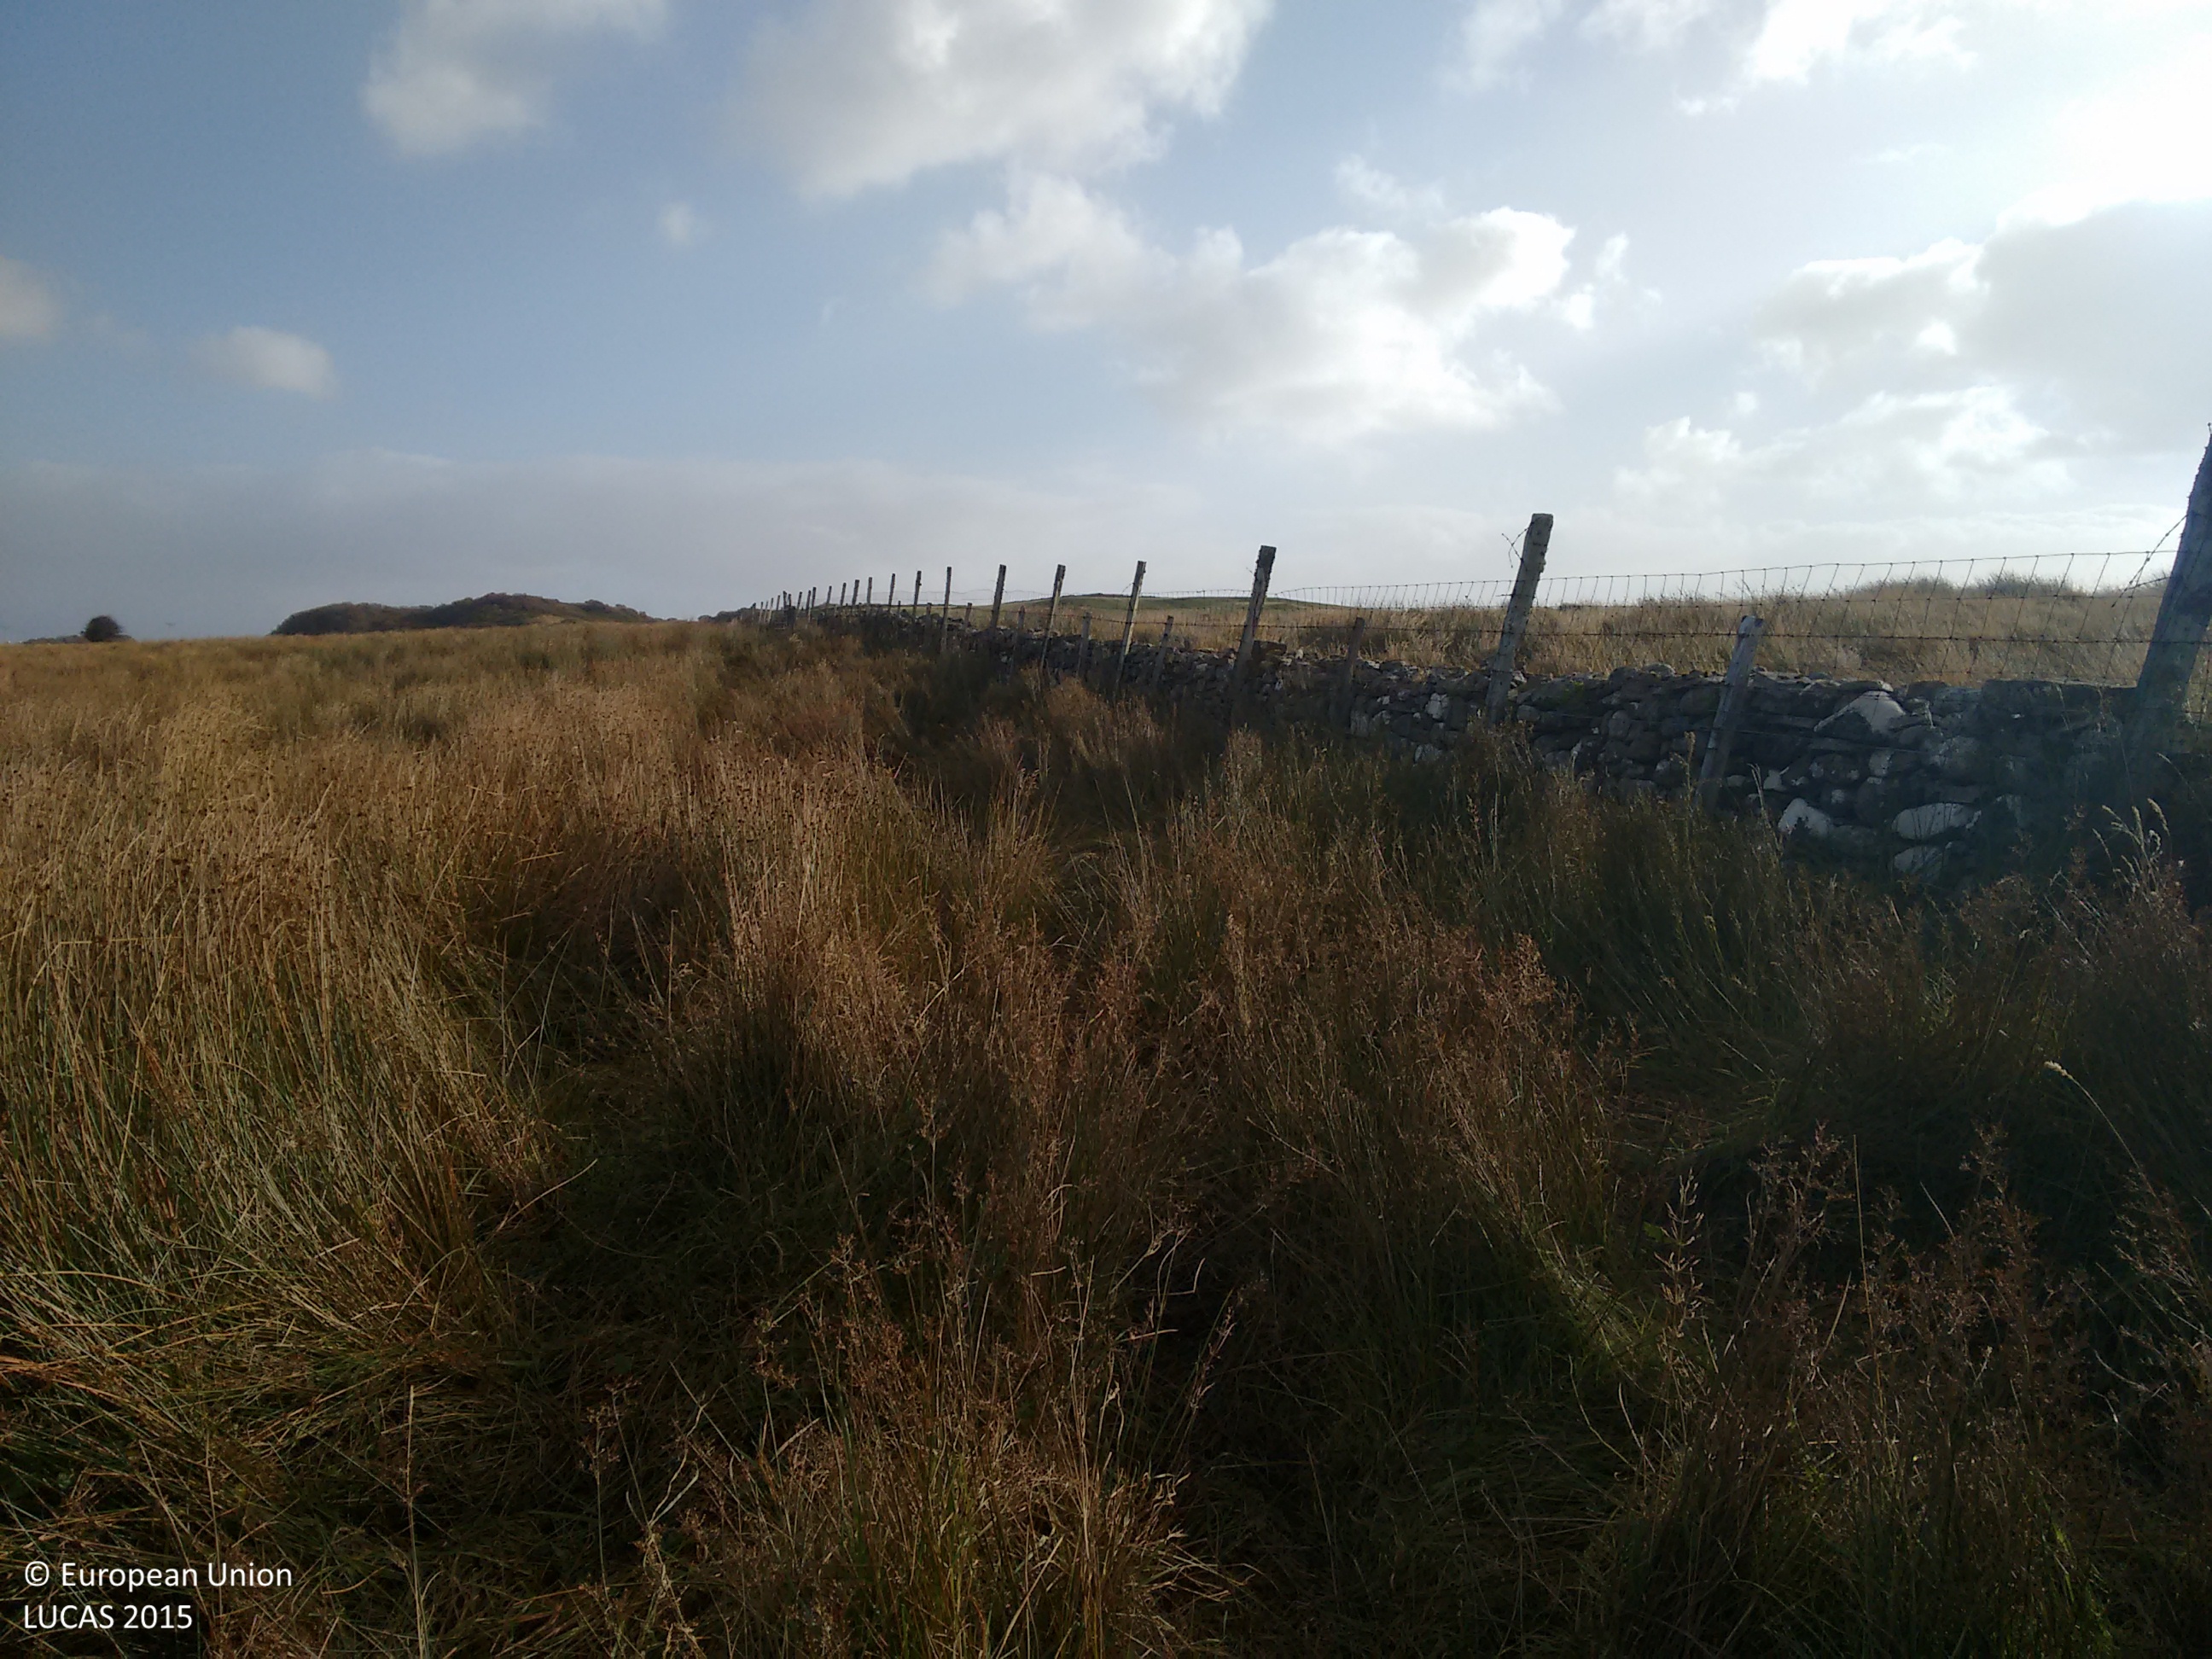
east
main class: Grassland
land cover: Grassland without tree/shrub cover
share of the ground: > 75 %
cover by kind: herbaceous plants 100 %
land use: Agriculture (excluding fallow land and kitchen gardens)
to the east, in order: Grassland without tree/shrub cover; Fences; Dry stone walls; Shrubland without tree cover; Fences; Grassland without tree/shrub cover; Broadleaved woodland; Ditches and canals; Broadleaved woodland
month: October
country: GB
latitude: 55.8045
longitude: -6.2412
